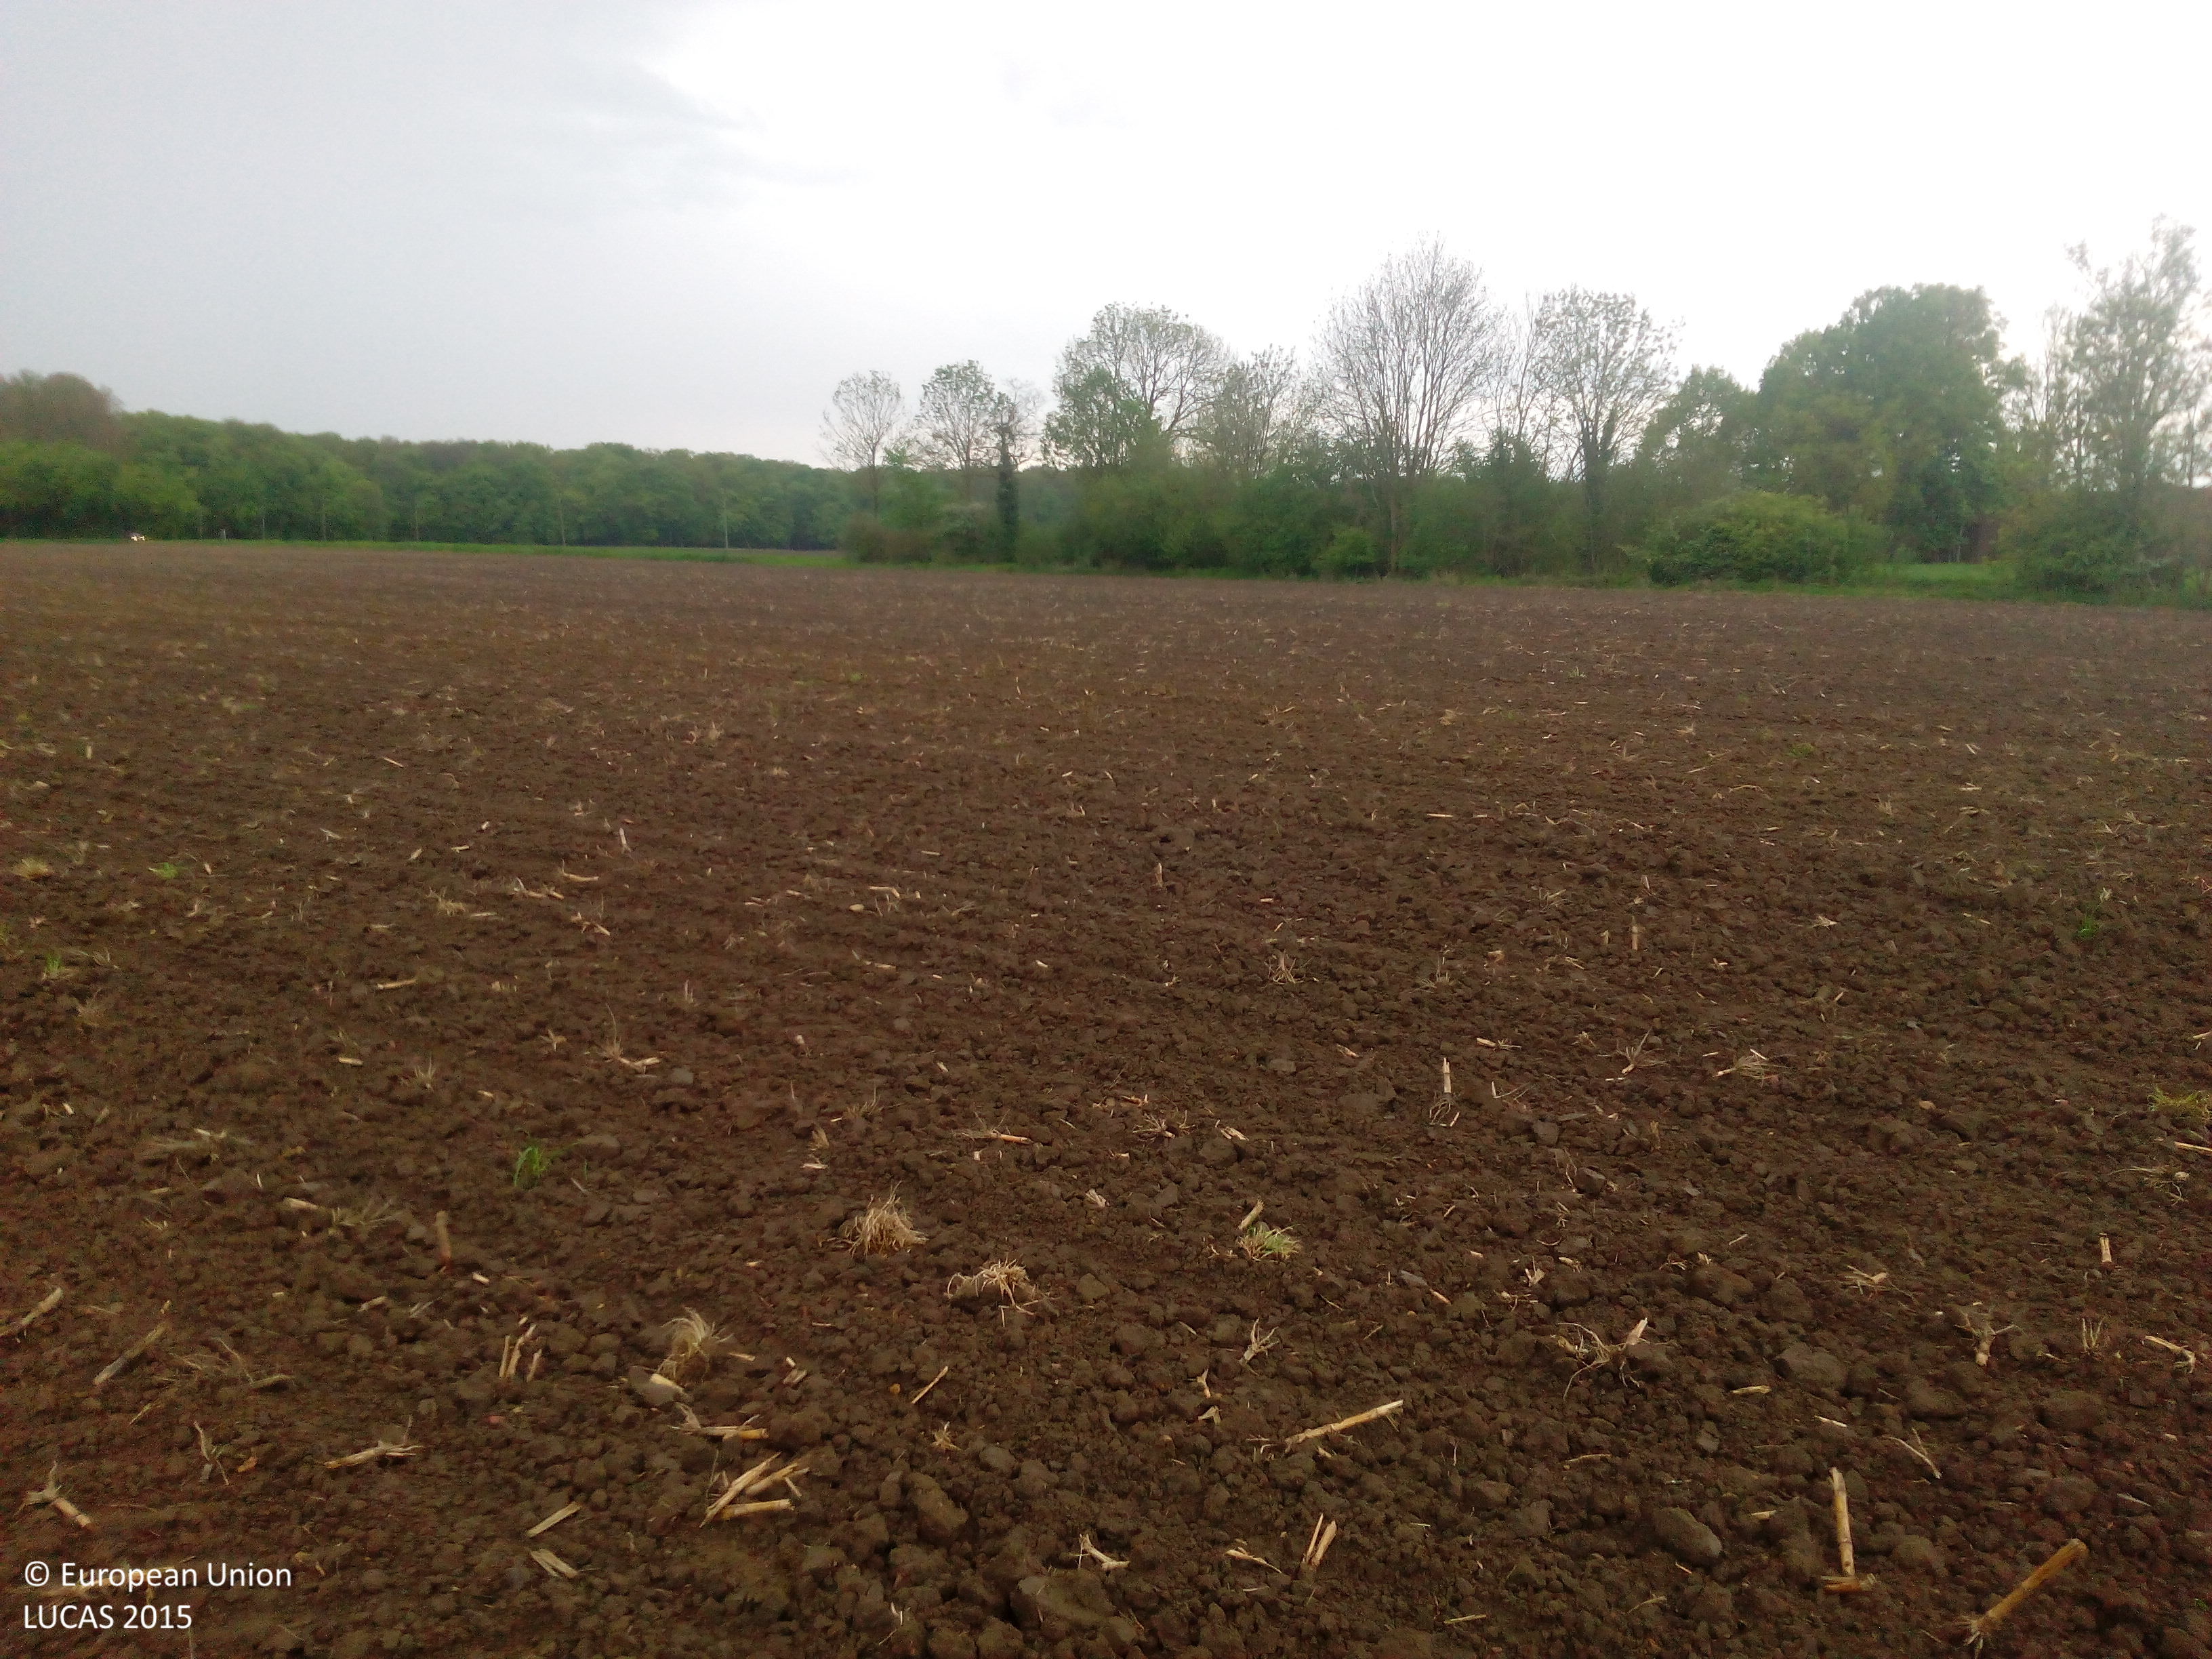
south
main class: Cropland
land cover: Maize
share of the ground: < 10 %
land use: Agriculture (excluding fallow land and kitchen gardens)
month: May
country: DE
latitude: 51.8648
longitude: 7.4589
